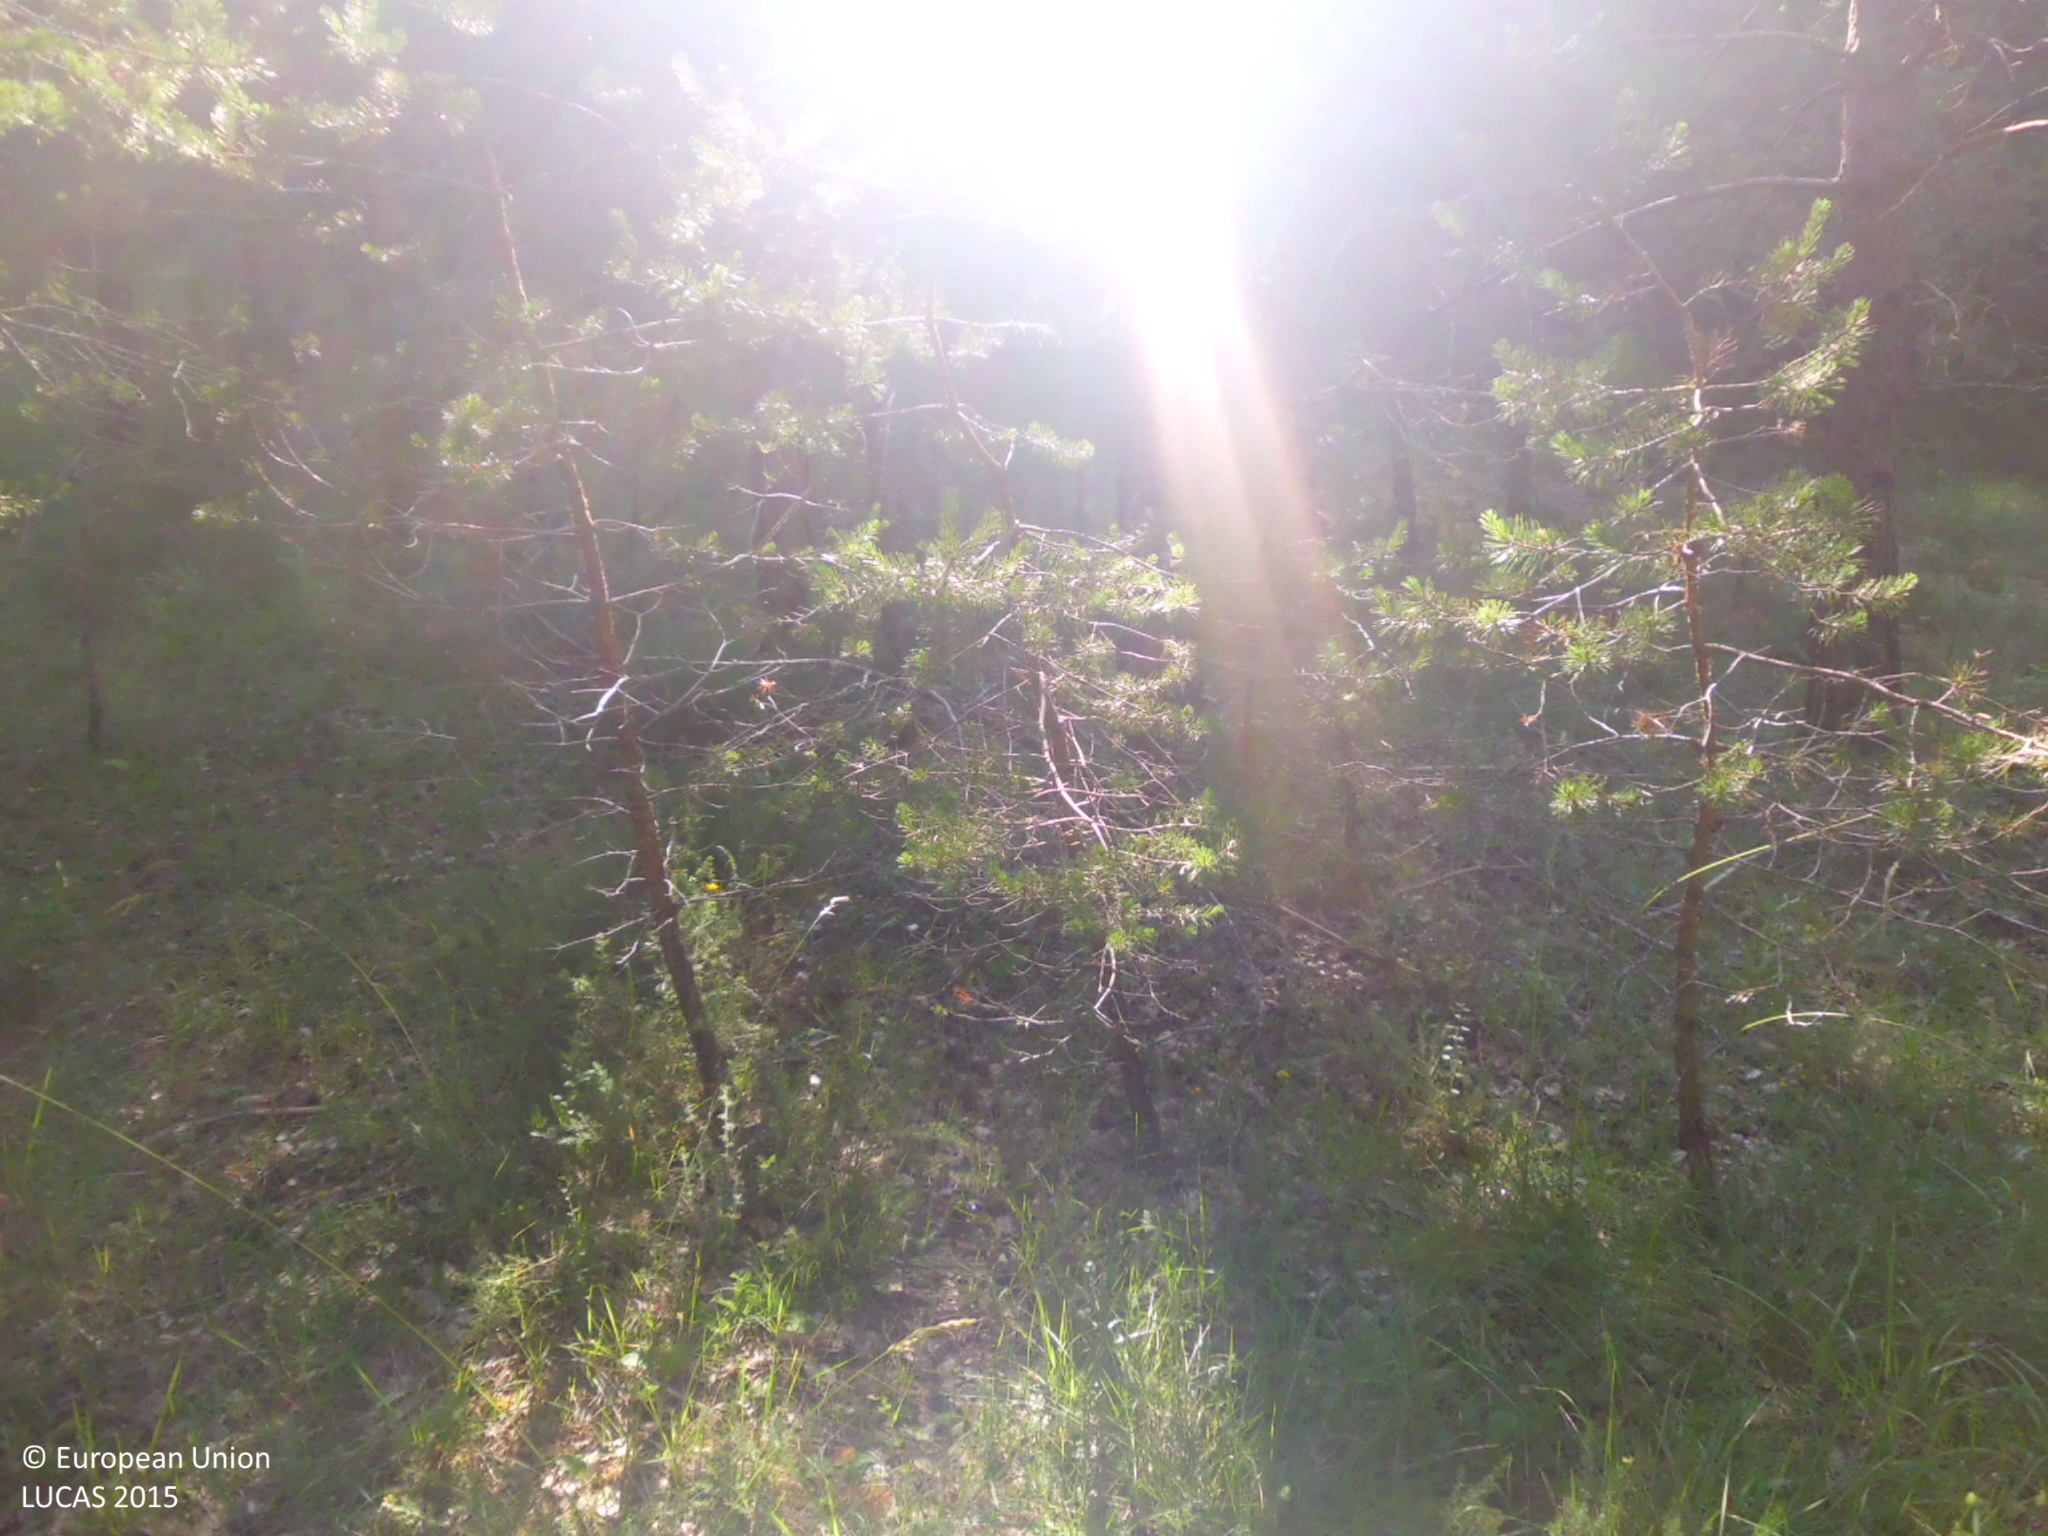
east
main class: Woodland
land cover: Pine dominated mixed woodland
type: coniferous forest of the mediterranean region
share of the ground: 50 - 75 %
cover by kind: coniferous forest trees 40 %, broadleaved forest trees 25 %, herbaceous plants 20 %, shrubs 15 %
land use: Forestry
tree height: > 5 m
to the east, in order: Pine dominated mixed woodland; Rivers and streams; Pine dominated mixed woodland; Rivers and streams; Pine dominated mixed woodland; Tracks; Pine dominated mixed woodland; Shrubland with sparse tree cover; Pine dominated mixed woodland
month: June
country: ES
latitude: 42.8991
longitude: -3.3488
